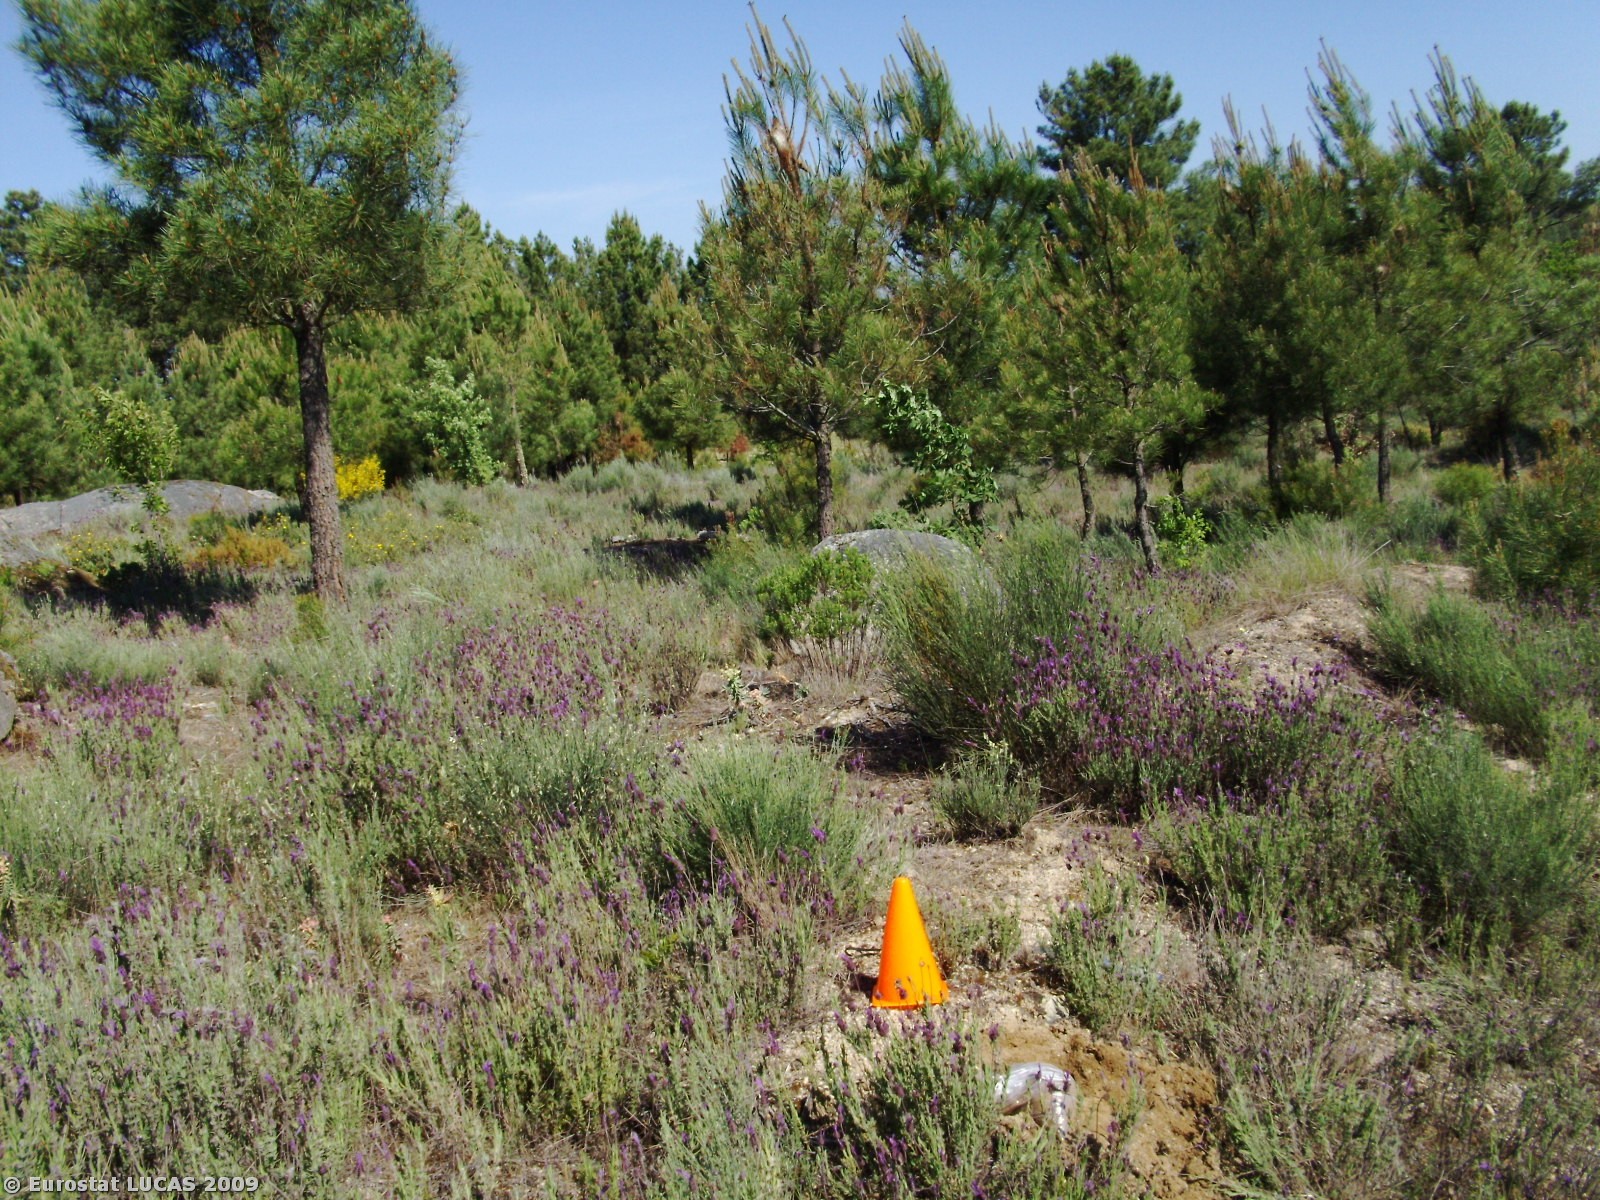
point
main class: Woodland
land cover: Coniferous woodland
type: coniferous forest of the mediterranean region
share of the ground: 25 - 50 %
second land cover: Shrubland with sparse tree cover
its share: 50 - 75 %
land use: Forestry
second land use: Fallow land
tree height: > 5 m
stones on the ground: 25 - 50 %
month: May
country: PT
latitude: 40.9239
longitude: -7.4420
